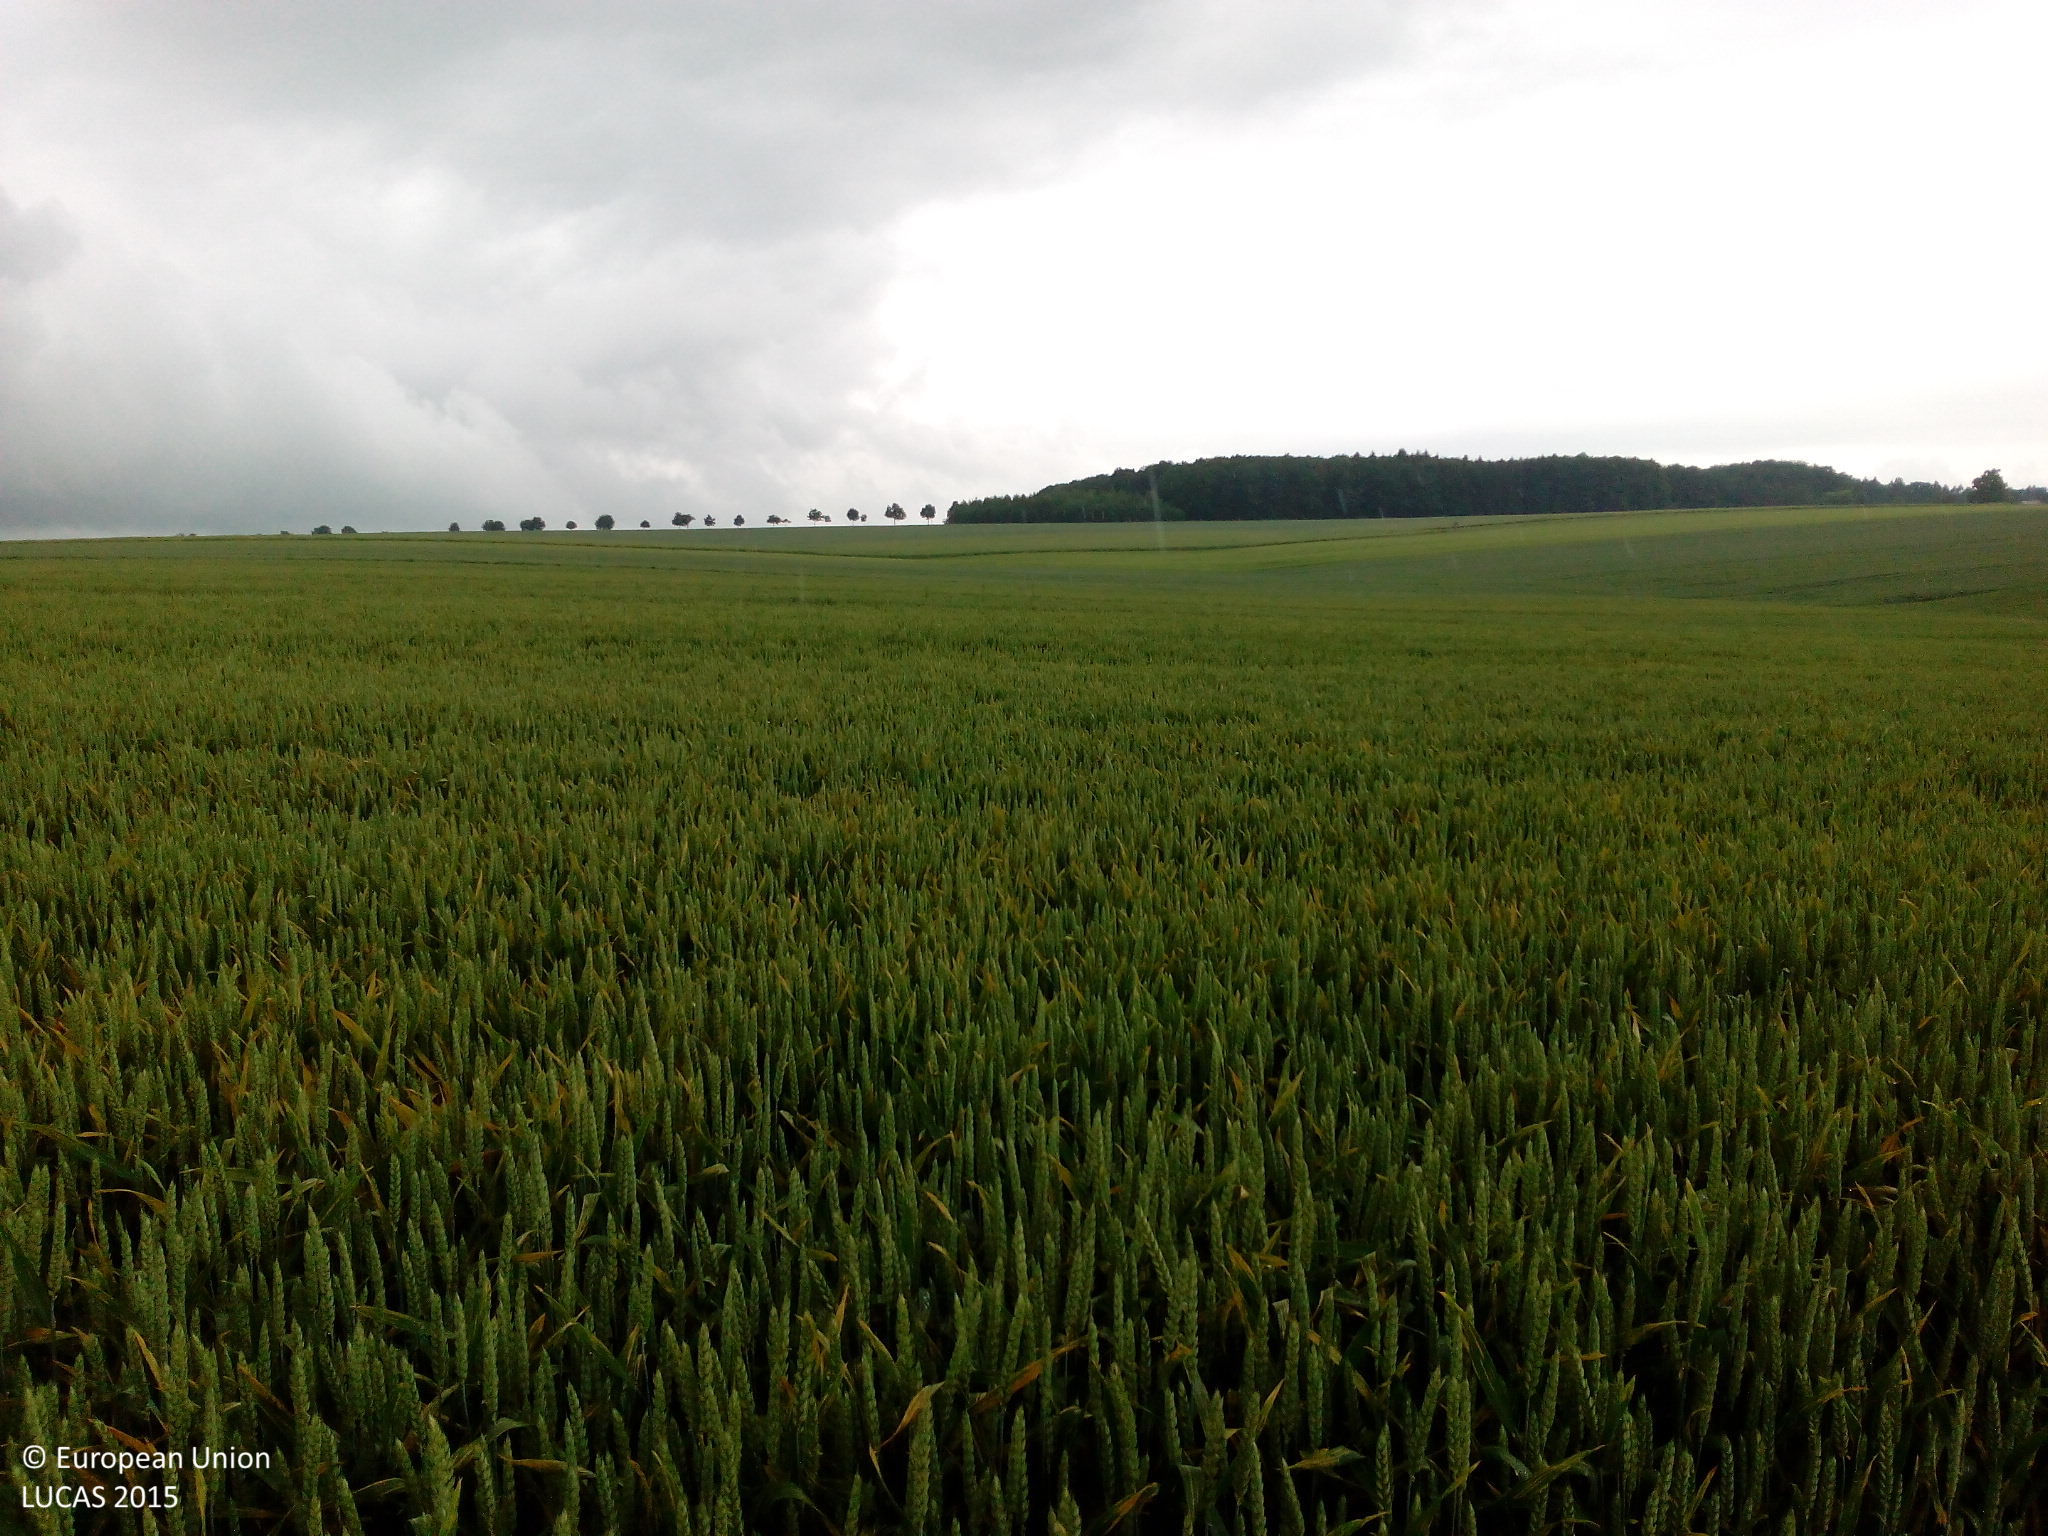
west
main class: Cropland
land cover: Common wheat
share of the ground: > 75 %
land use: Agriculture (excluding fallow land and kitchen gardens)
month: June
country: DE
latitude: 51.0060
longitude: 13.0927
